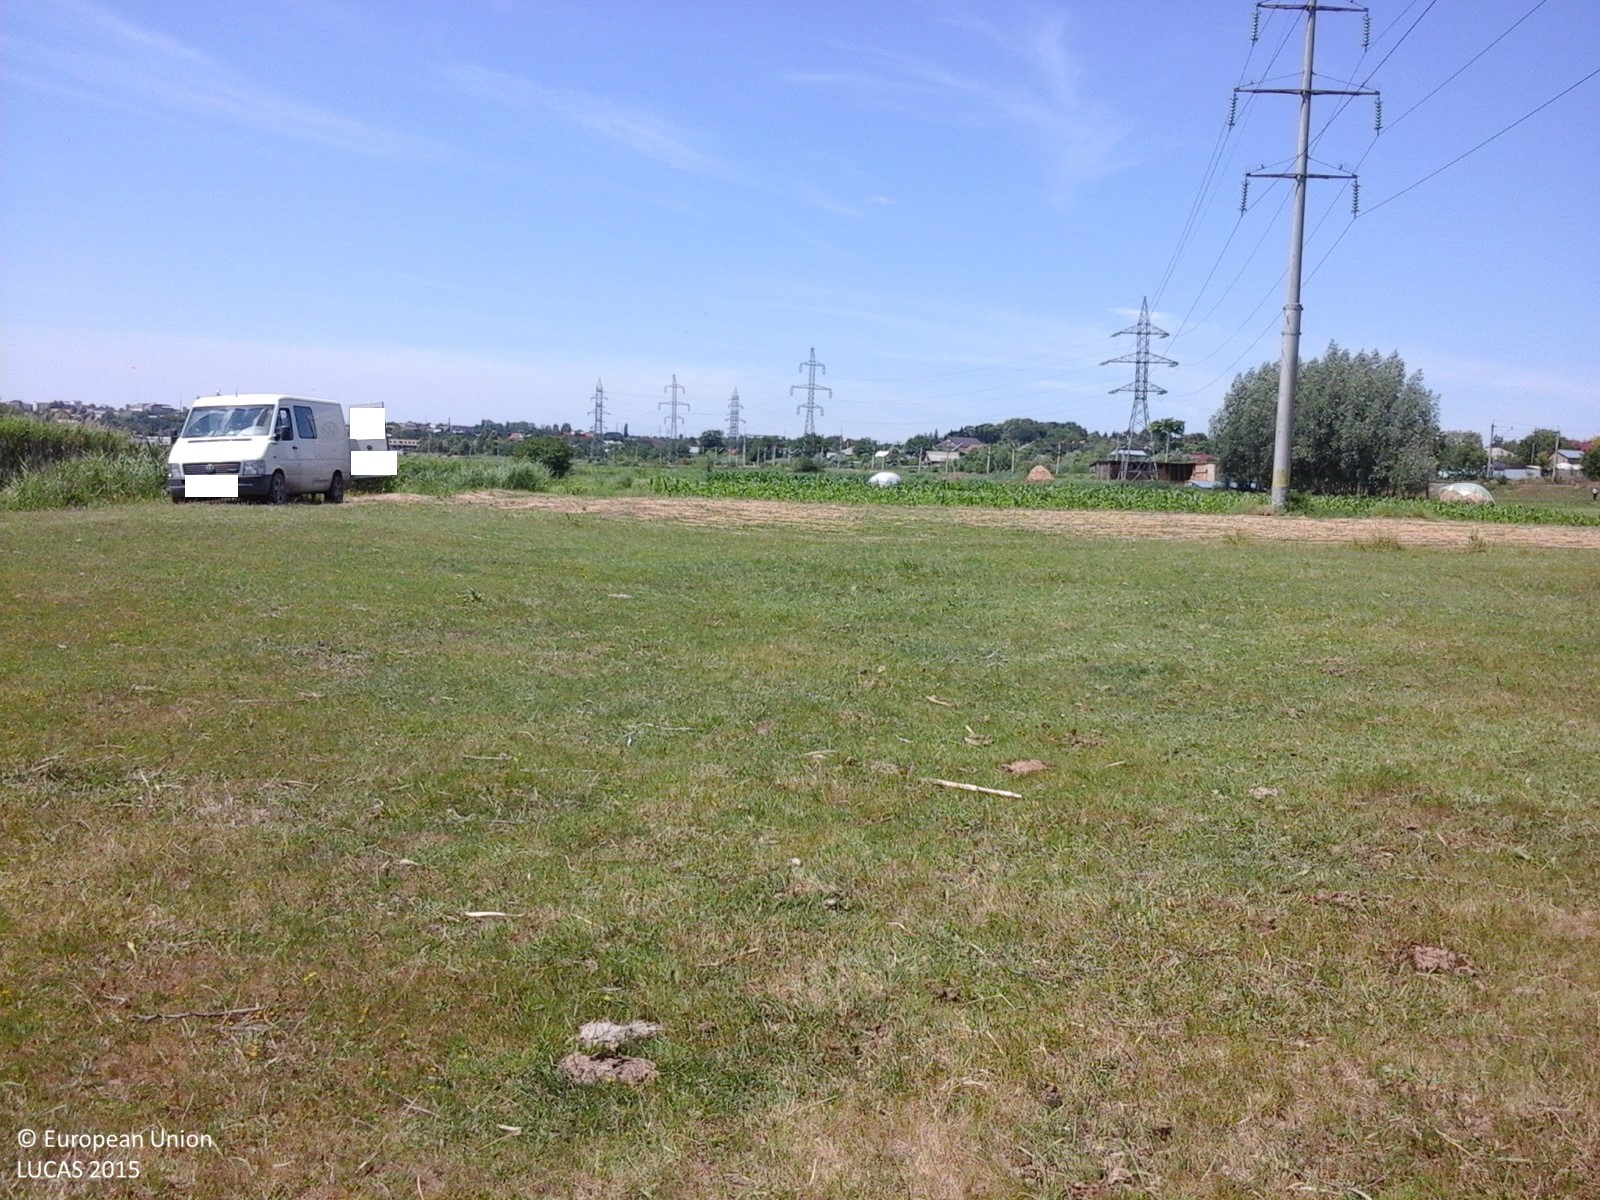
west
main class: Grassland
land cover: Grassland without tree/shrub cover
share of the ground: > 75 %
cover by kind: herbaceous plants 100 %
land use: Agriculture (excluding fallow land and kitchen gardens)
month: June
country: RO
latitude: 47.2142
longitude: 27.0430
